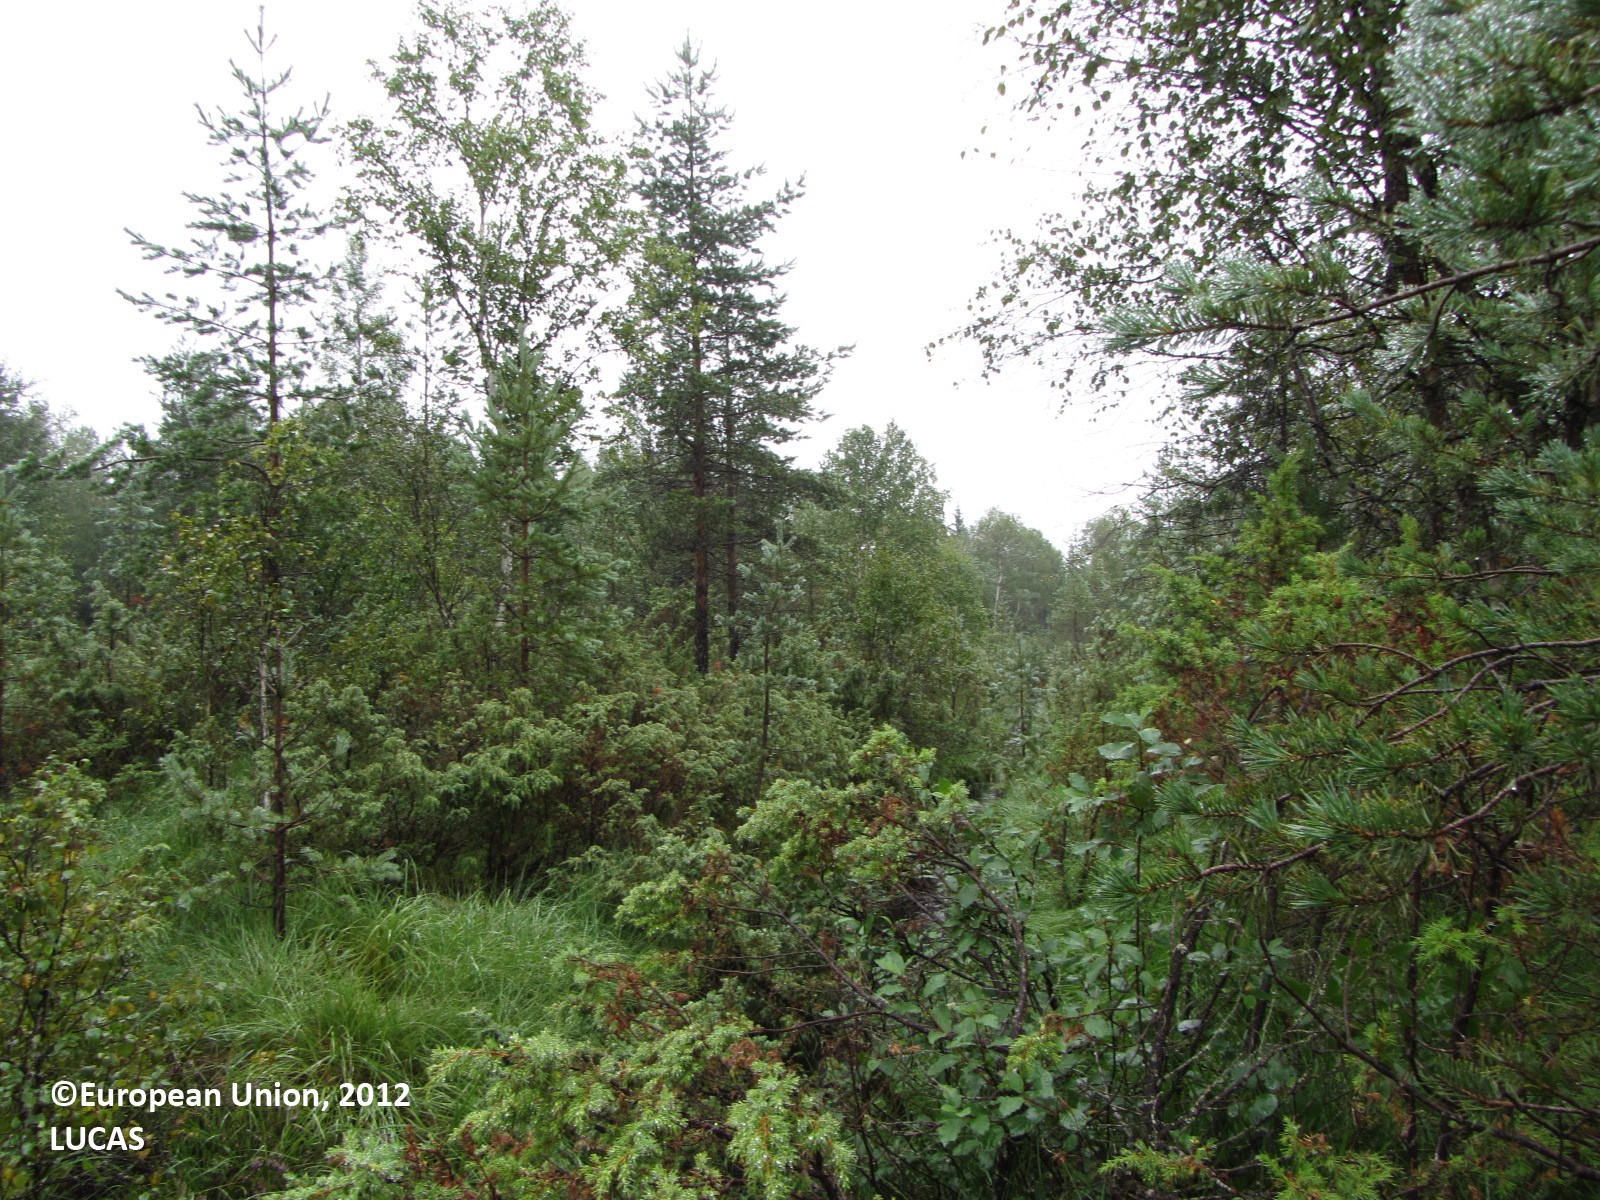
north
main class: Woodland
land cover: Pine dominated mixed woodland
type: boreal forest
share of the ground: > 75 %
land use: Forestry
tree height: > 5 m
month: August
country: FI
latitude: 63.3558
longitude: 24.5328
